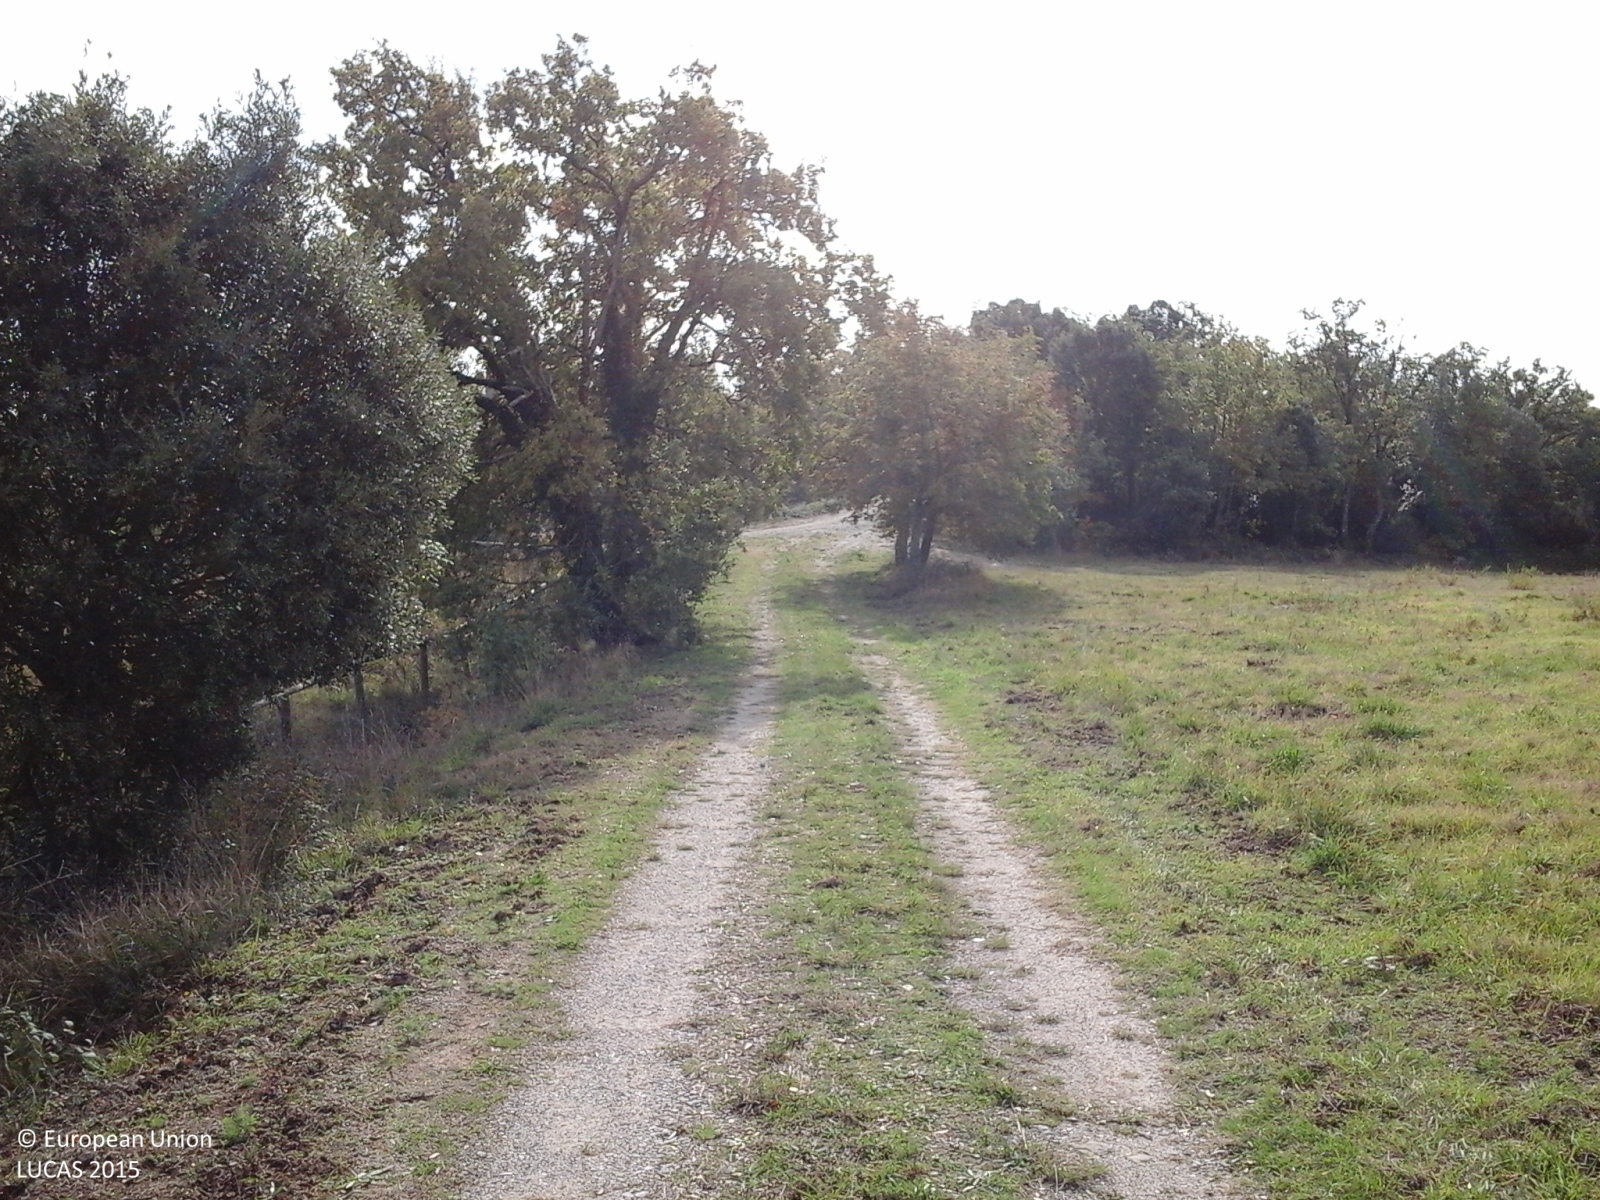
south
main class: Grassland
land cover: Grassland without tree/shrub cover
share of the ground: > 75 %
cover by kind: herbaceous plants 100 %
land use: Agriculture (excluding fallow land and kitchen gardens)
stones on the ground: < 10 %
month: October
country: IT
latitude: 43.4184
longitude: 11.5642
